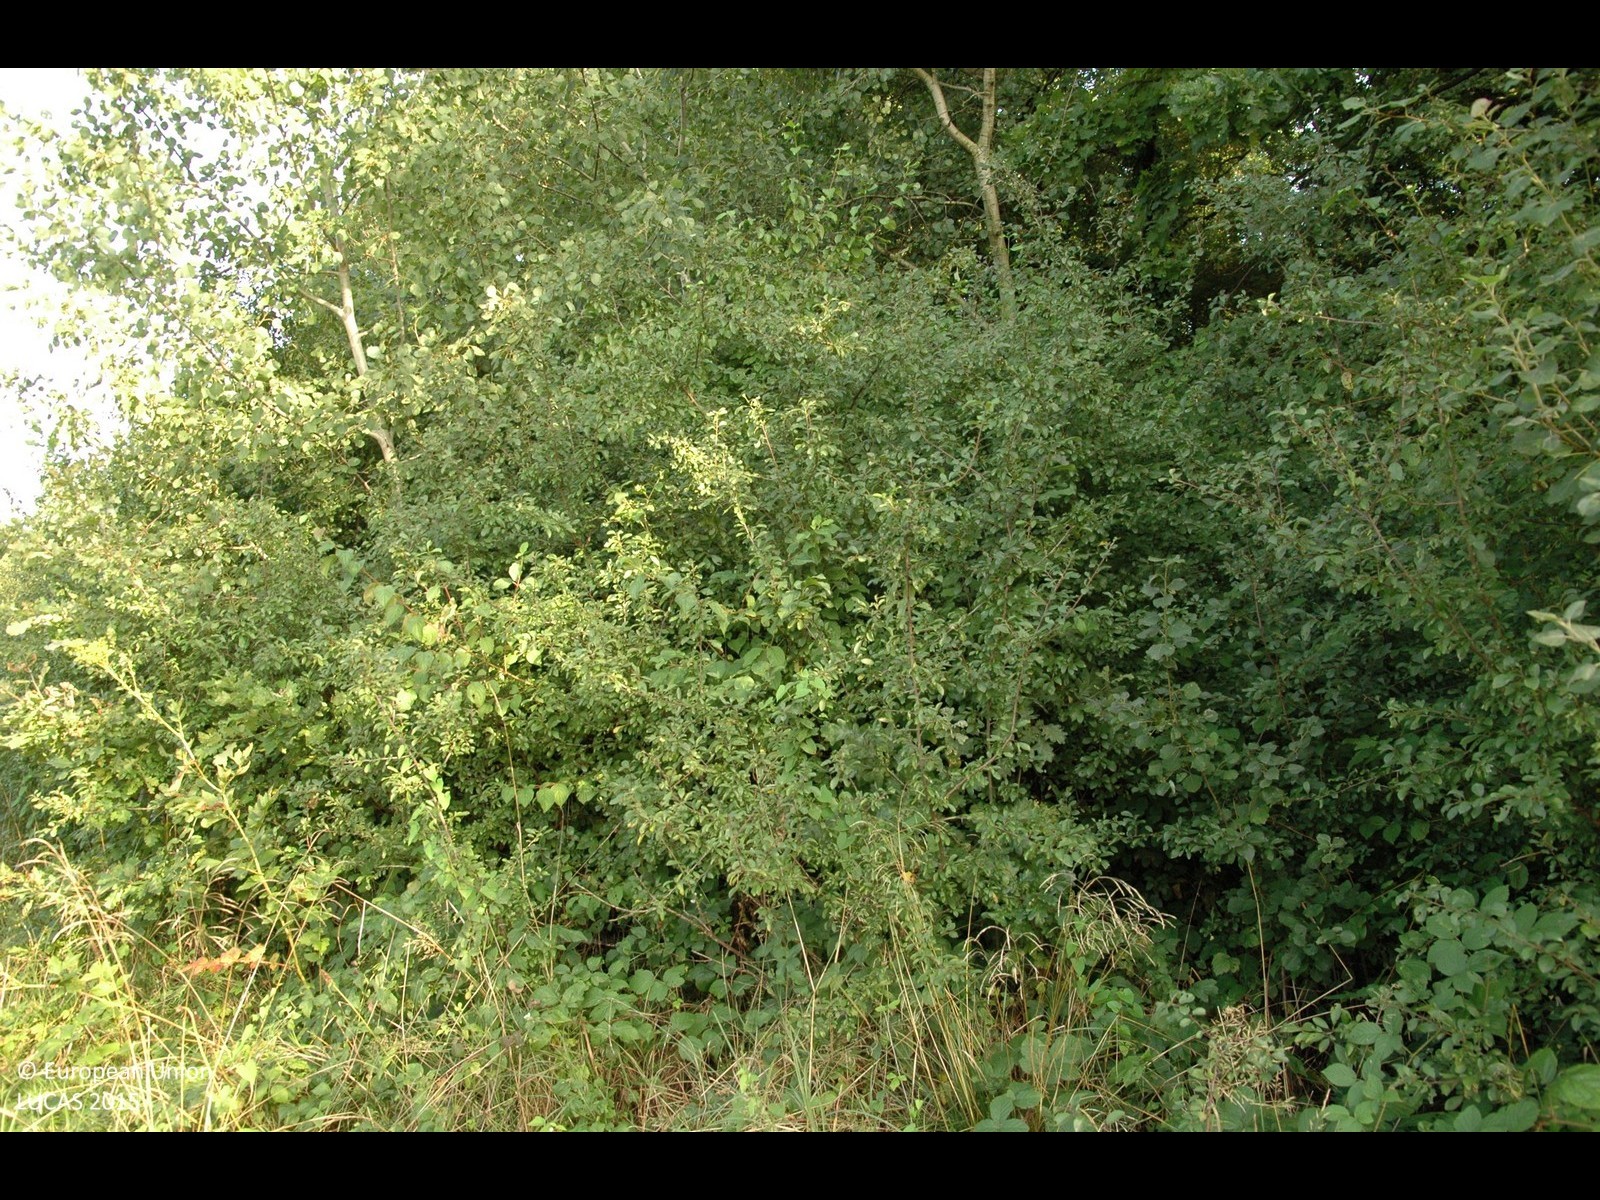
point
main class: Shrubland
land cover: Shrubland with sparse tree cover
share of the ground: > 75 %
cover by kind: shrubs 95 %, broadleaved forest trees 5 %
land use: Semi-natural and natural areas not in use
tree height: > 5 m
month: August
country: HR
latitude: 45.8152
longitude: 16.1113
